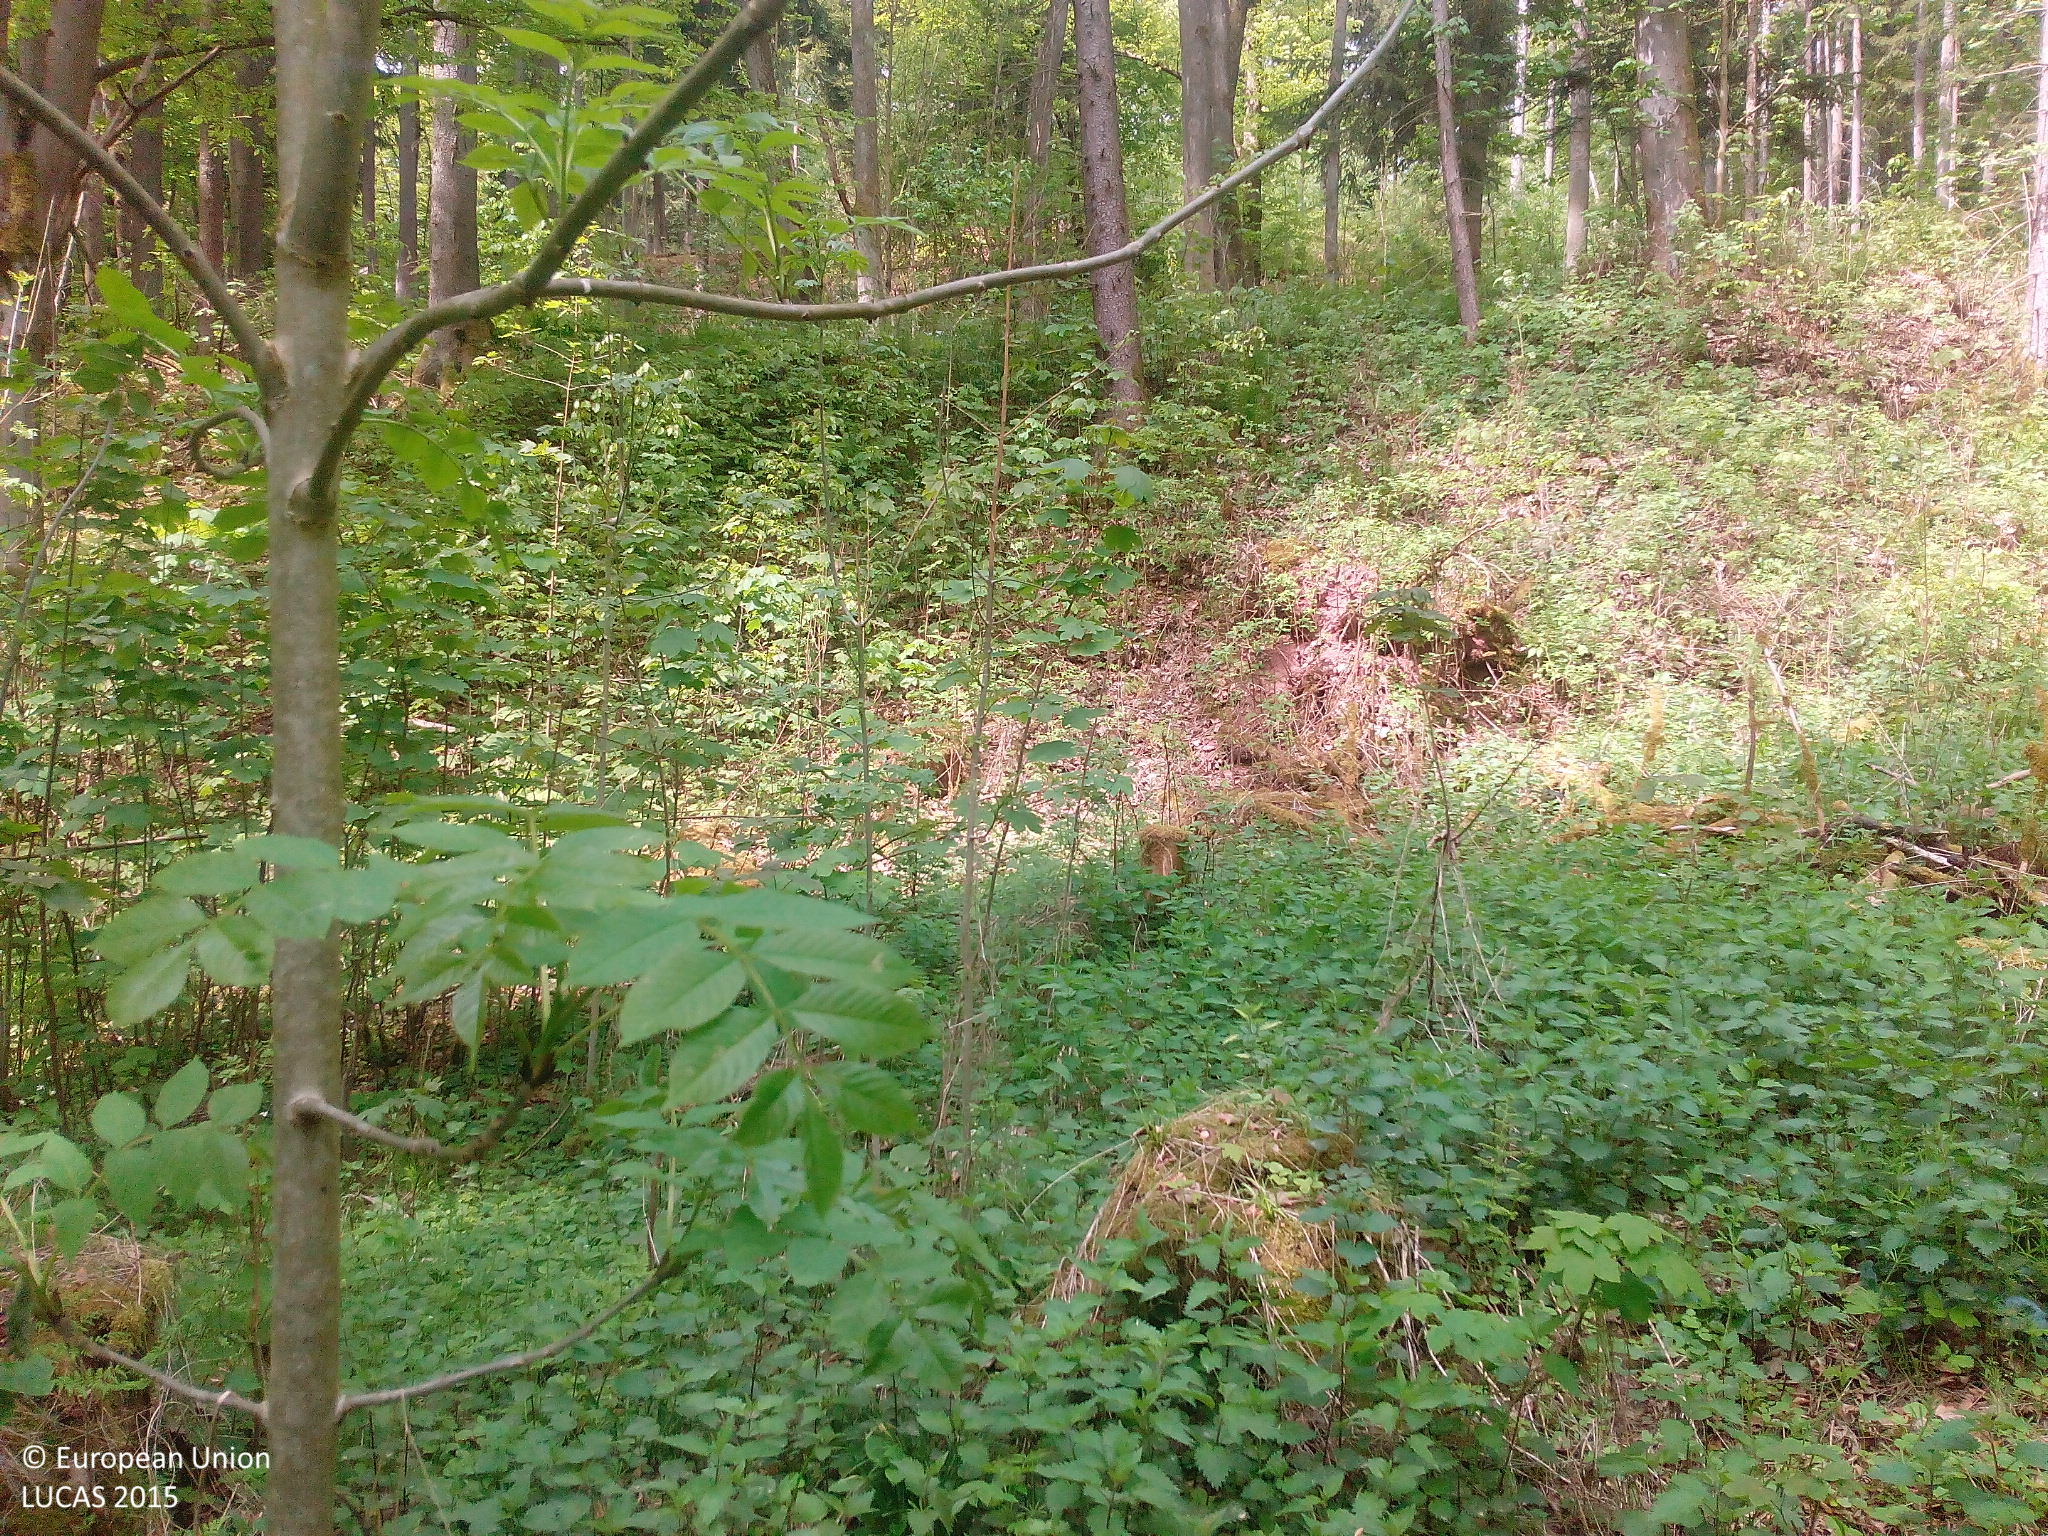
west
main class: Woodland
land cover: Broadleaved woodland
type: mesophytic deciduous forest
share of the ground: > 75 %
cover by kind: broadleaved forest trees 90 %, shrubs 10 %
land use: Forestry
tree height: > 5 m
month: May
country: DE
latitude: 50.3235
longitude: 11.0251
